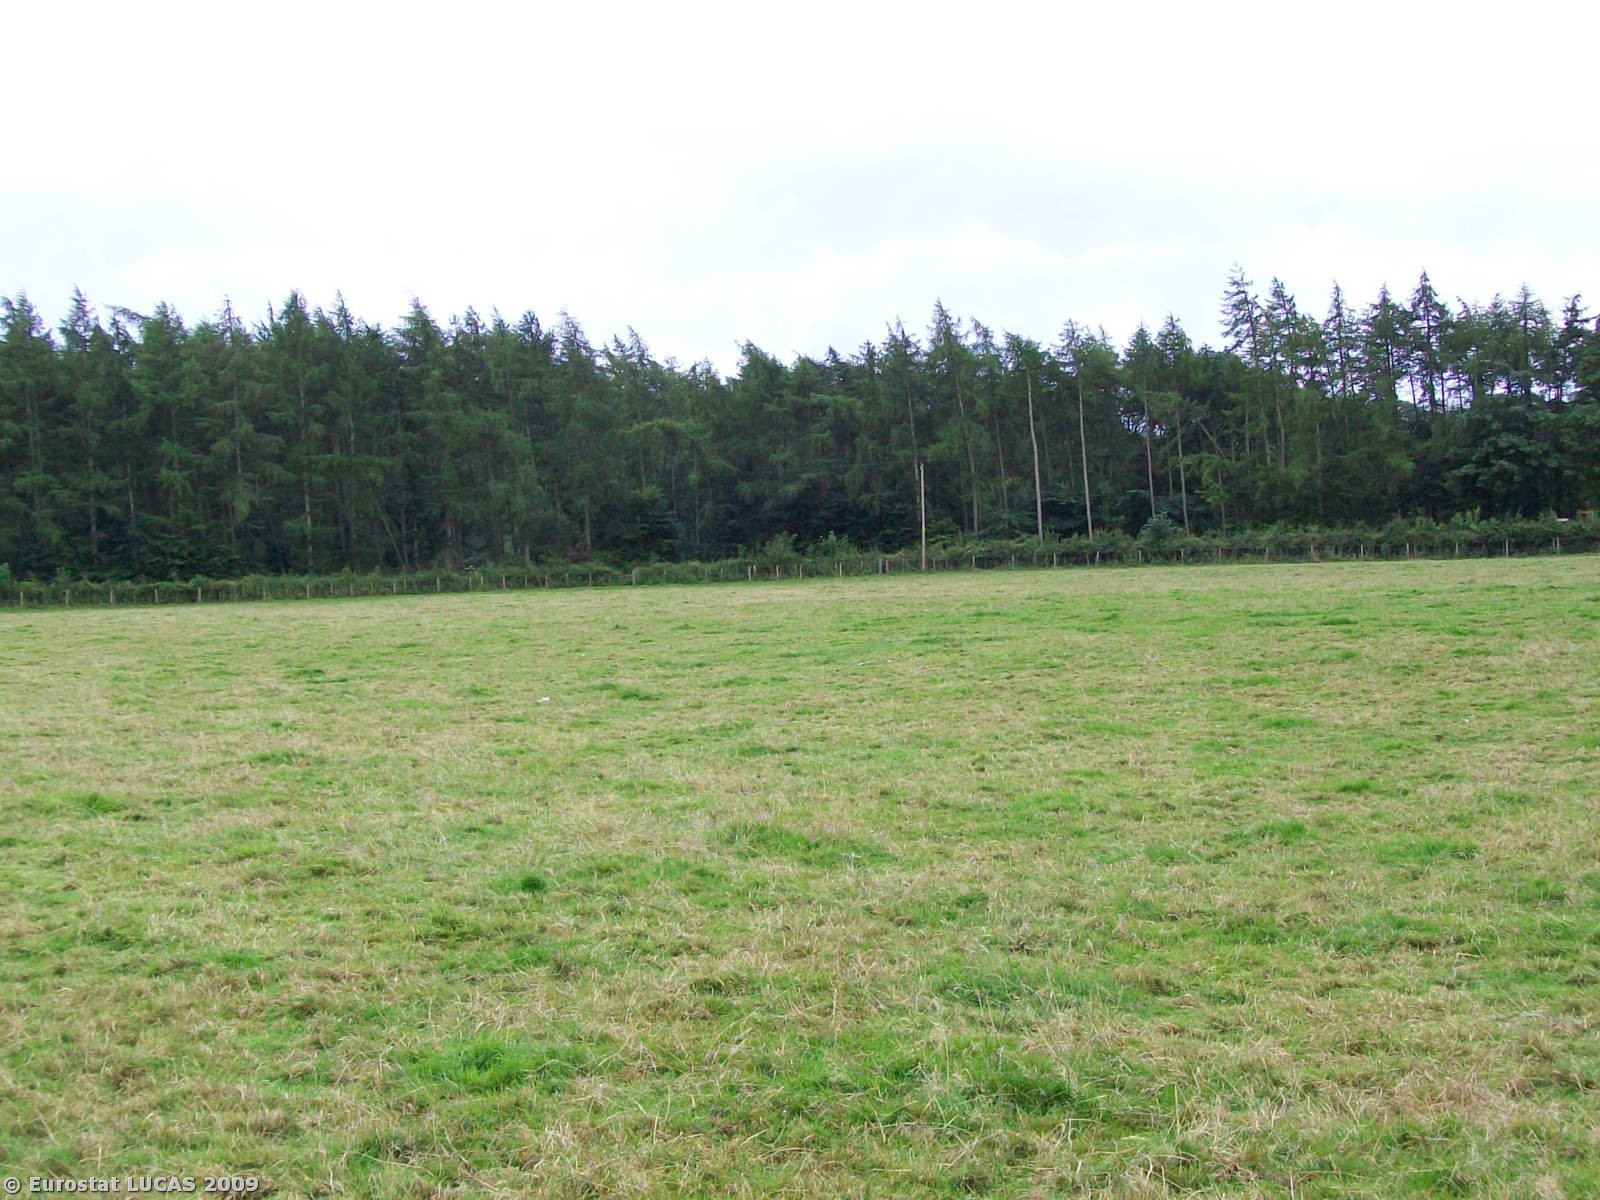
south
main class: Grassland
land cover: Grassland without tree/shrub cover
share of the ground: > 75 %
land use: Agriculture (excluding fallow land and kitchen gardens)
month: July
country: GB
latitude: 55.0496
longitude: -3.3348
